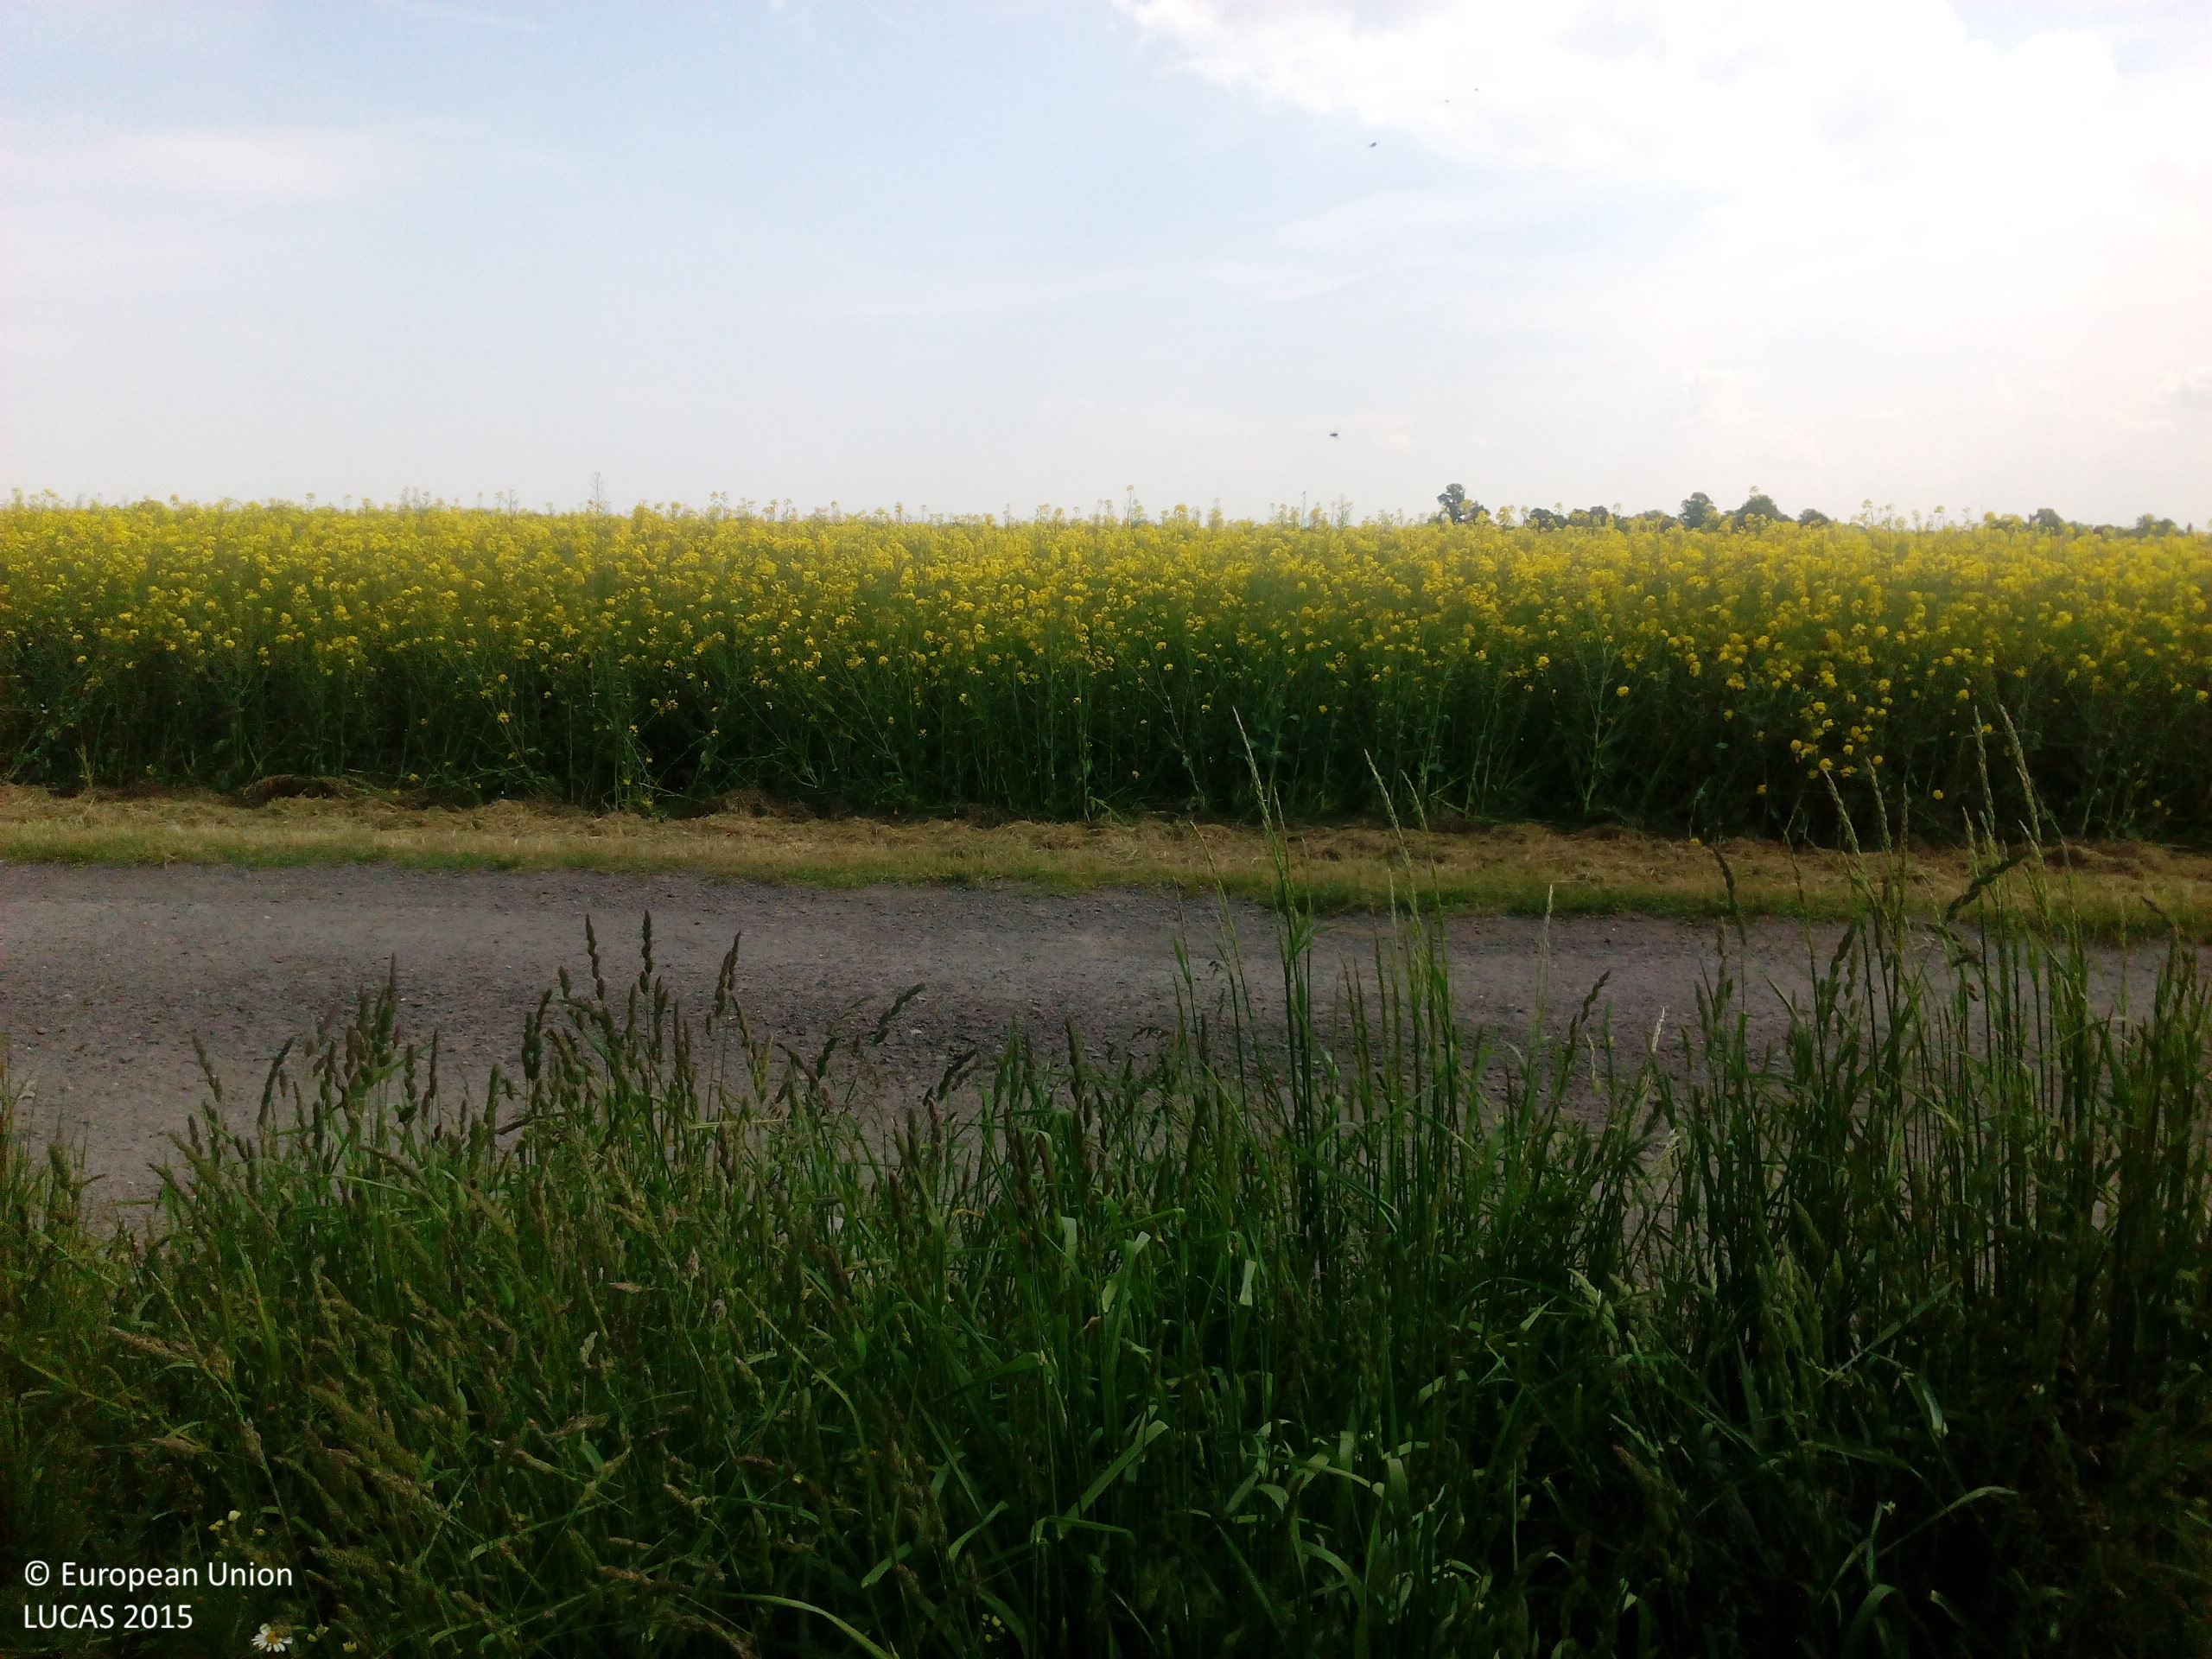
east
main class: Cropland
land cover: Rape and turnip rape
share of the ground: > 75 %
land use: Agriculture (excluding fallow land and kitchen gardens)
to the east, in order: Rape and turnip rape; Grass margins; Tracks; Grass margins; Rape and turnip rape
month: May
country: DE
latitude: 51.4580
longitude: 12.2017
